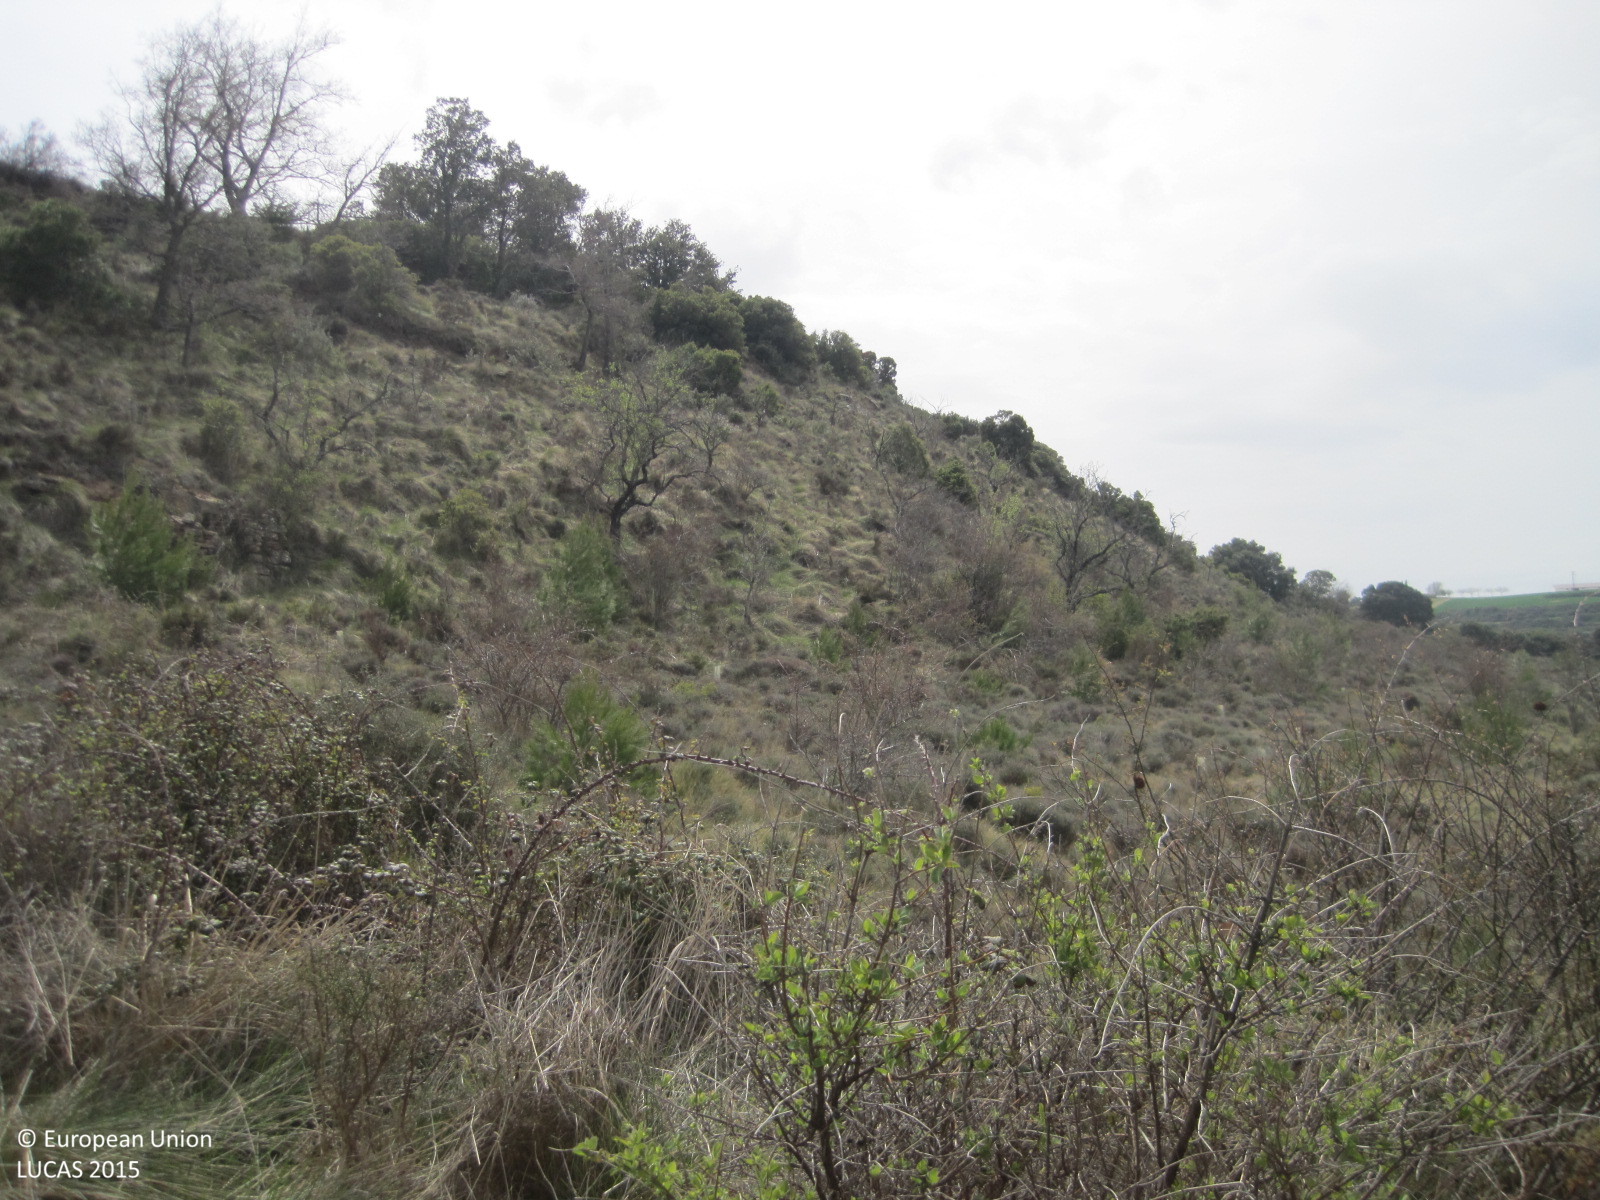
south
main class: Woodland
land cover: Pine dominated mixed woodland
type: coniferous forest of the mediterranean region
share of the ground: 10 - 25 %
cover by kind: herbaceous plants 65 %, coniferous forest trees 15 %, shrubs 10 %, broadleaved forest trees 5 %, unconsolidated bare surface 5 %
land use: Forestry
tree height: < 5 m
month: April
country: ES
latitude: 42.5748
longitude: -2.4606
